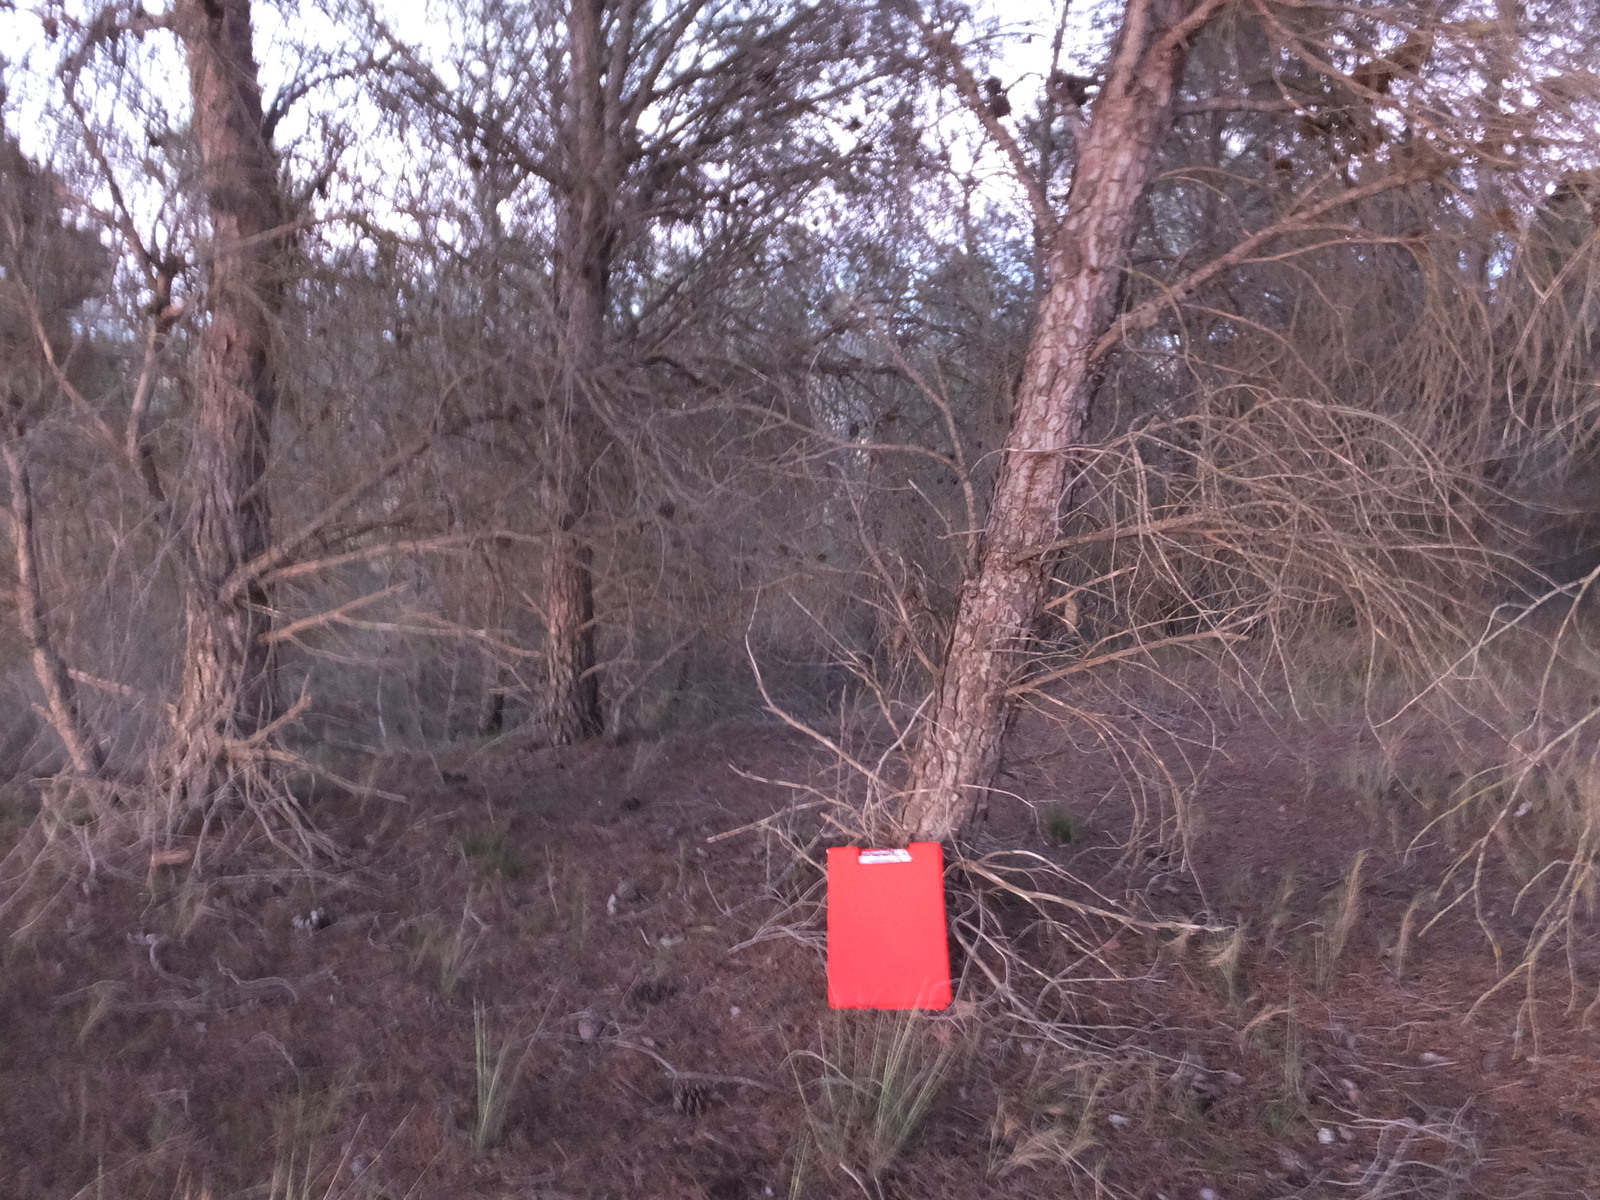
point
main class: Woodland
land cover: Pine dominated coniferous woodland
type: coniferous forest of the mediterranean region
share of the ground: 50 - 75 %
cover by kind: coniferous forest trees 75 %, herbaceous plants 25 %
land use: Forestry
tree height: > 5 m
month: April
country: ES
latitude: 41.7528
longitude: -0.2285
